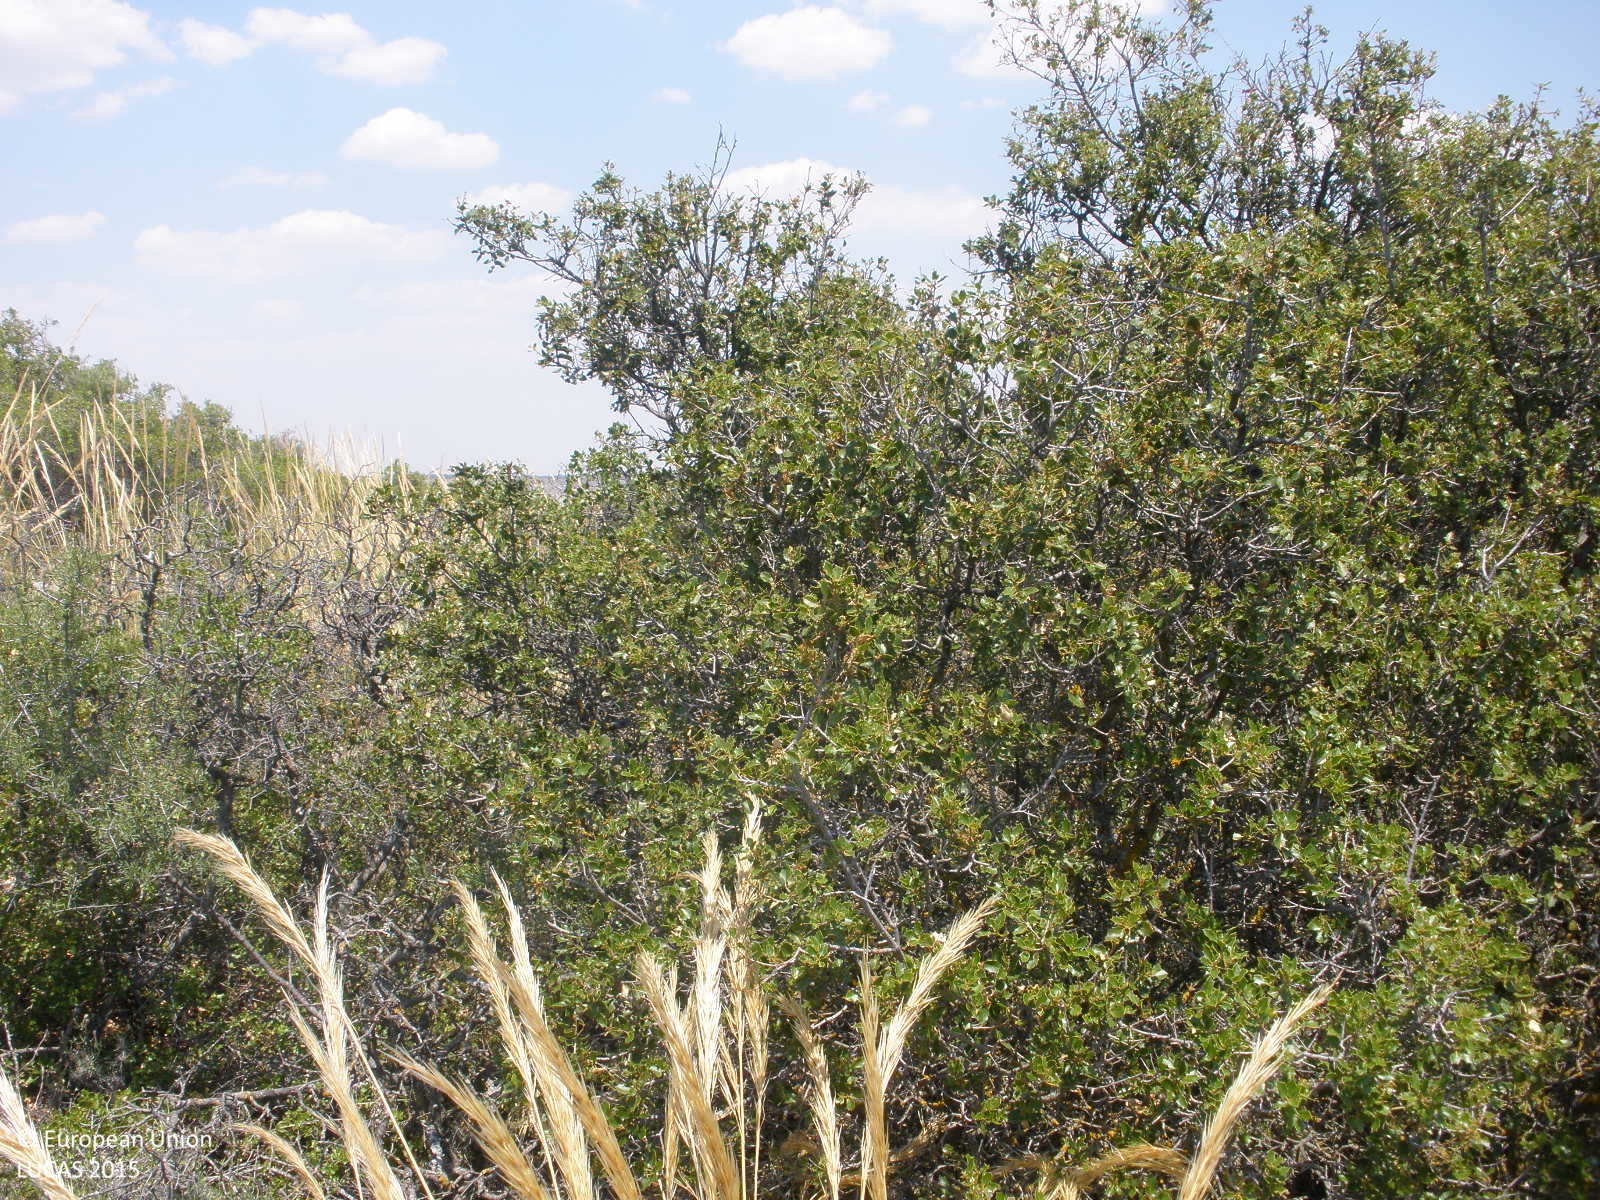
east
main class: Woodland
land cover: Broadleaved woodland
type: broadleaved evergreen forest
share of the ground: 25 - 50 %
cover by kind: herbaceous plants 45 %, broadleaved forest trees 30 %, shrubs 20 %, consolidated bare surface 5 %
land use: Semi-natural and natural areas not in use
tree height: < 5 m
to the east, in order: Broadleaved woodland; Tracks; Dry stone walls; Shrubland with sparse tree cover; Olive groves; Shruby margins; Tracks; Shrubland without tree cover
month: June
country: ES
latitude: 40.2246
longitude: -3.2502
